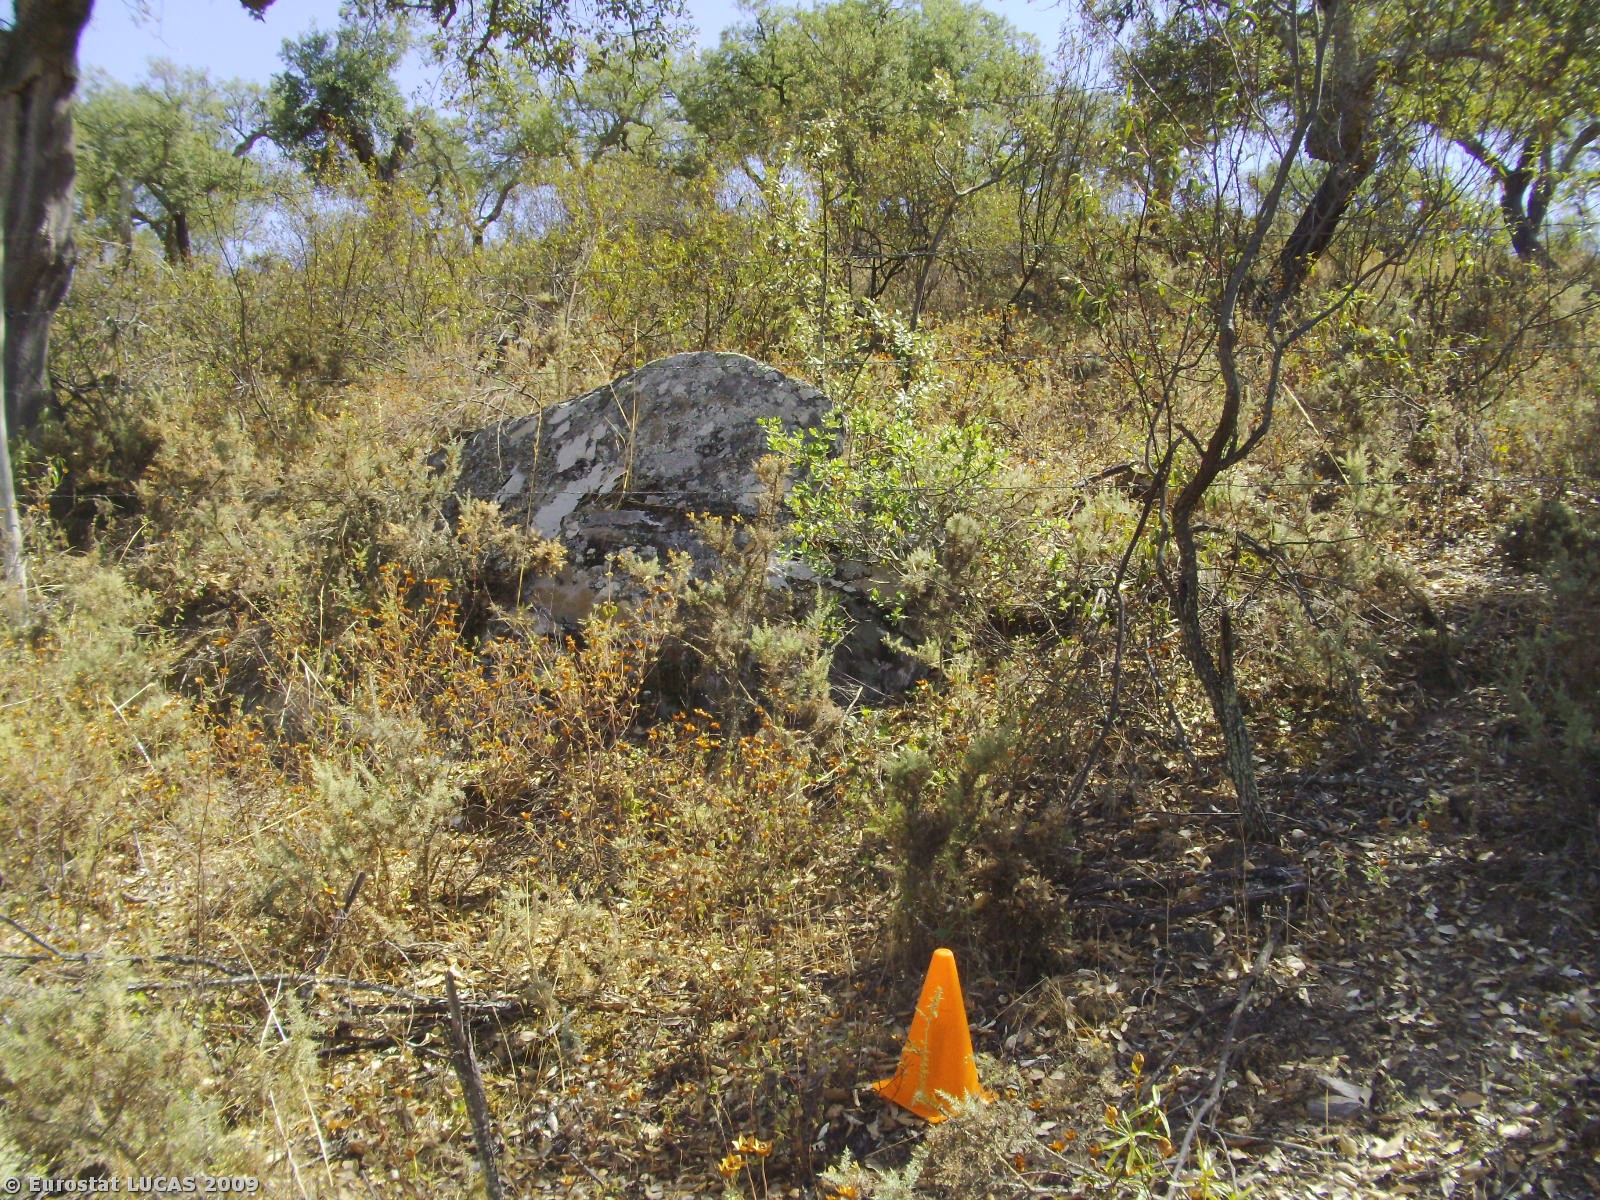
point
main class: Woodland
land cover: Broadleaved woodland
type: broadleaved evergreen forest
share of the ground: 50 - 75 %
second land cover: Shrubland with sparse tree cover
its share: 50 - 75 %
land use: Forestry
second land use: Unused
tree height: > 5 m
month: August
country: PT
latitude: 38.0668
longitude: -7.1211
